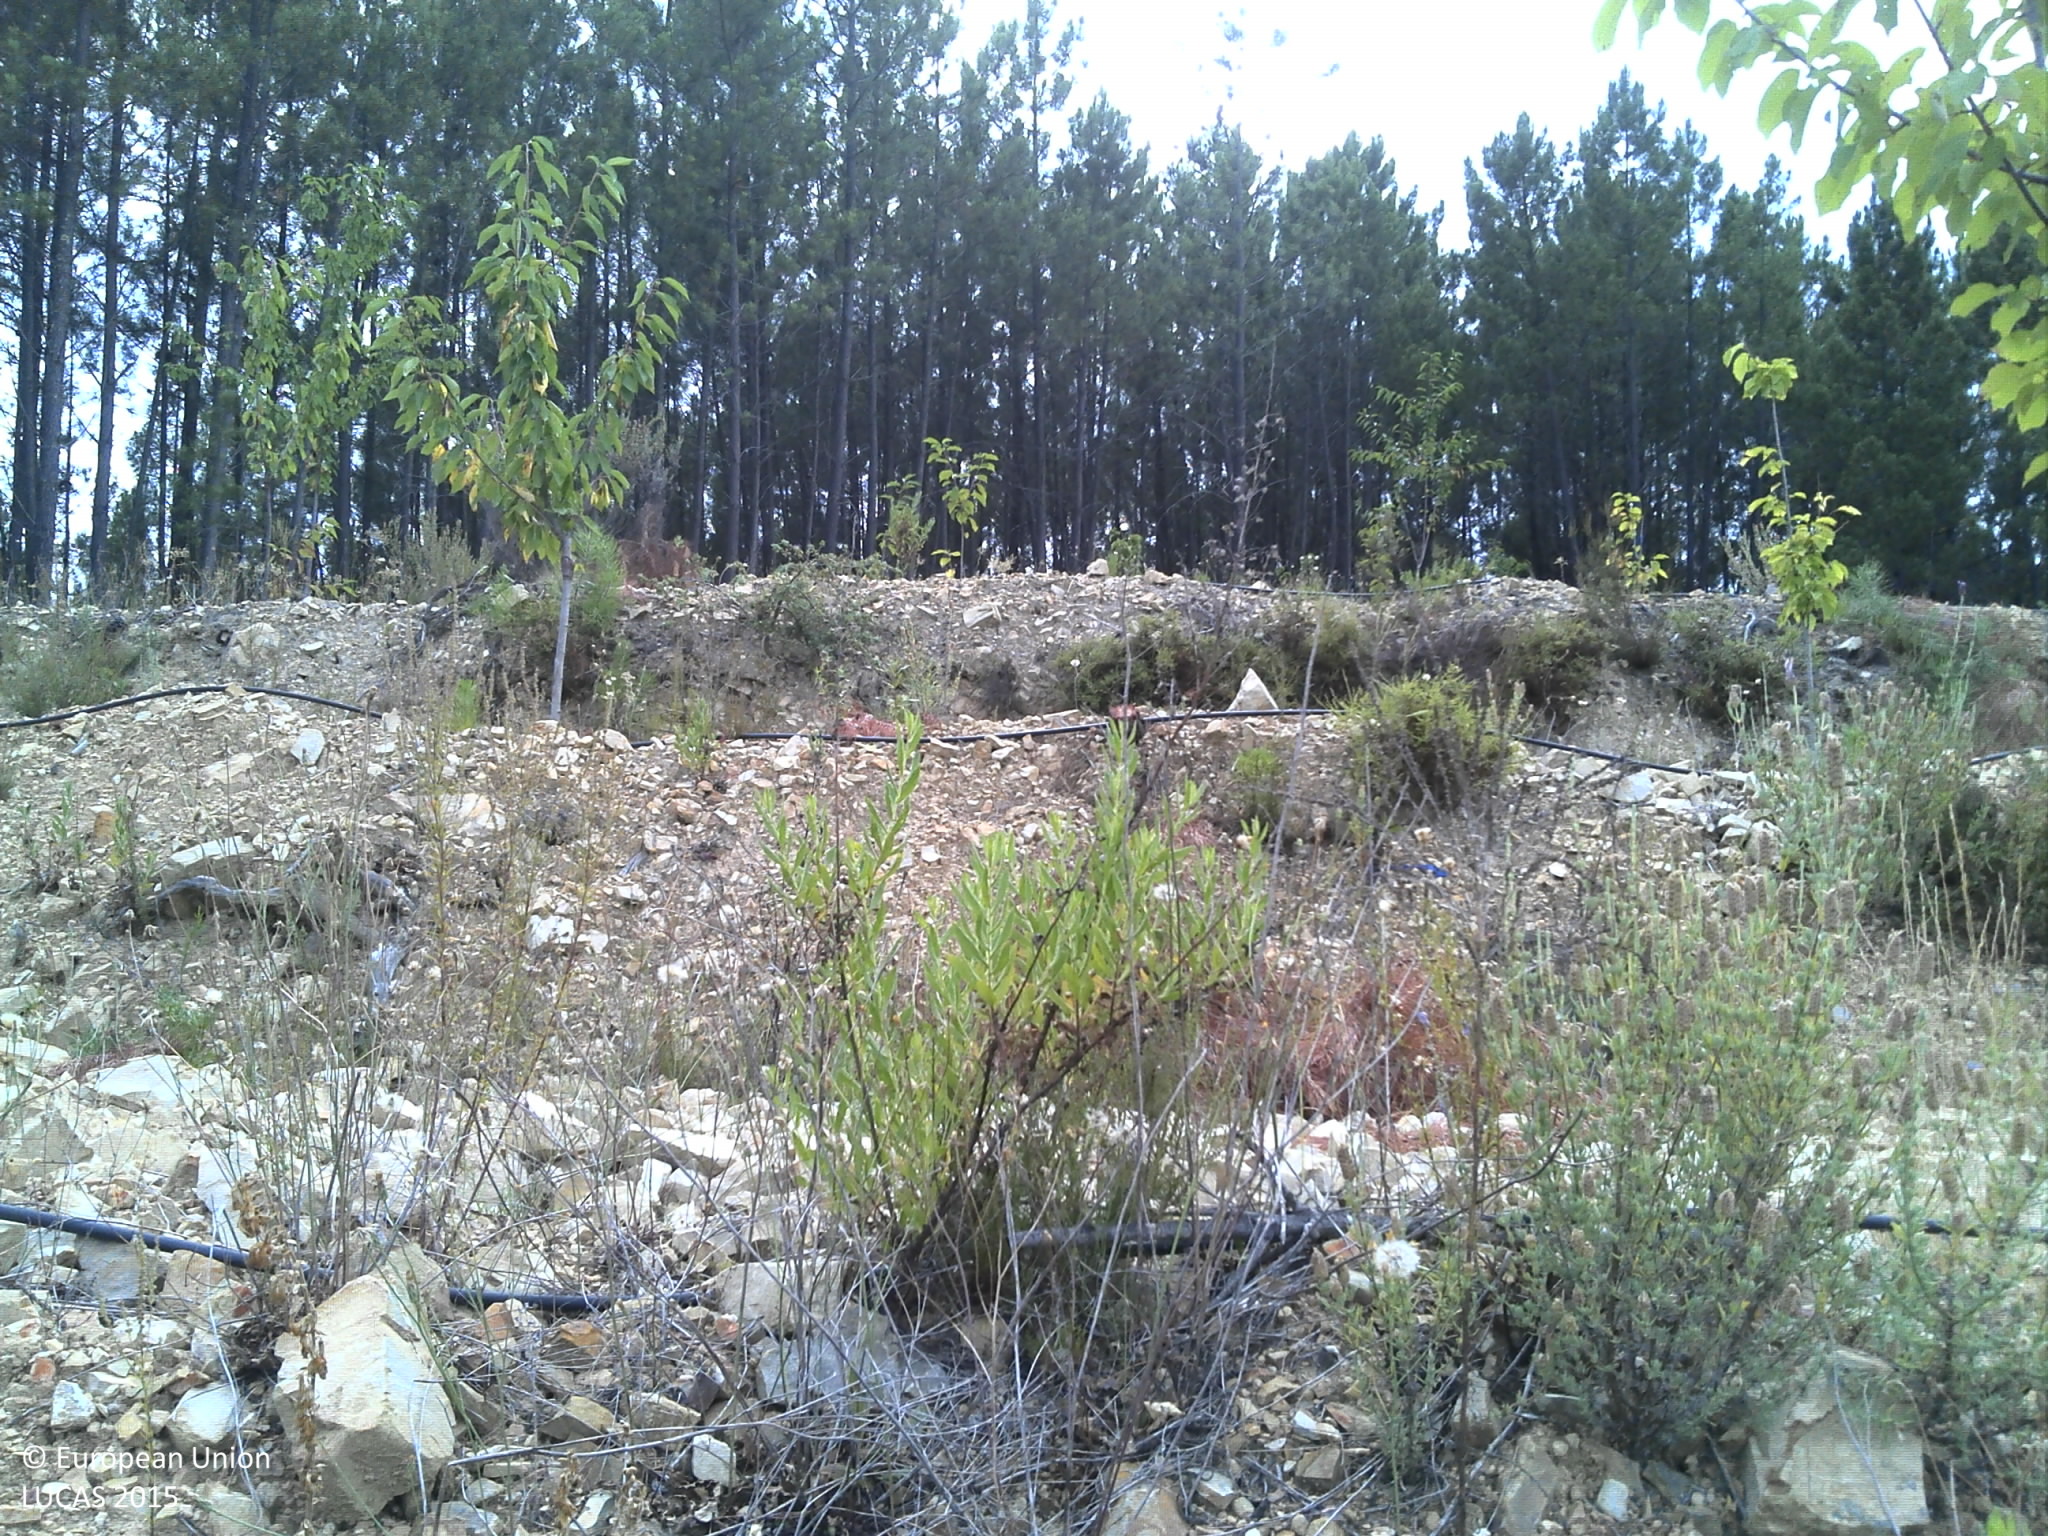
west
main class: Cropland
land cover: Cherry fruit
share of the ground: < 10 %
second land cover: Shrubland without tree cover
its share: 10 - 25 %
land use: Agriculture (excluding fallow land and kitchen gardens)
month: July
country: PT
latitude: 39.6456
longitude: -7.9723
